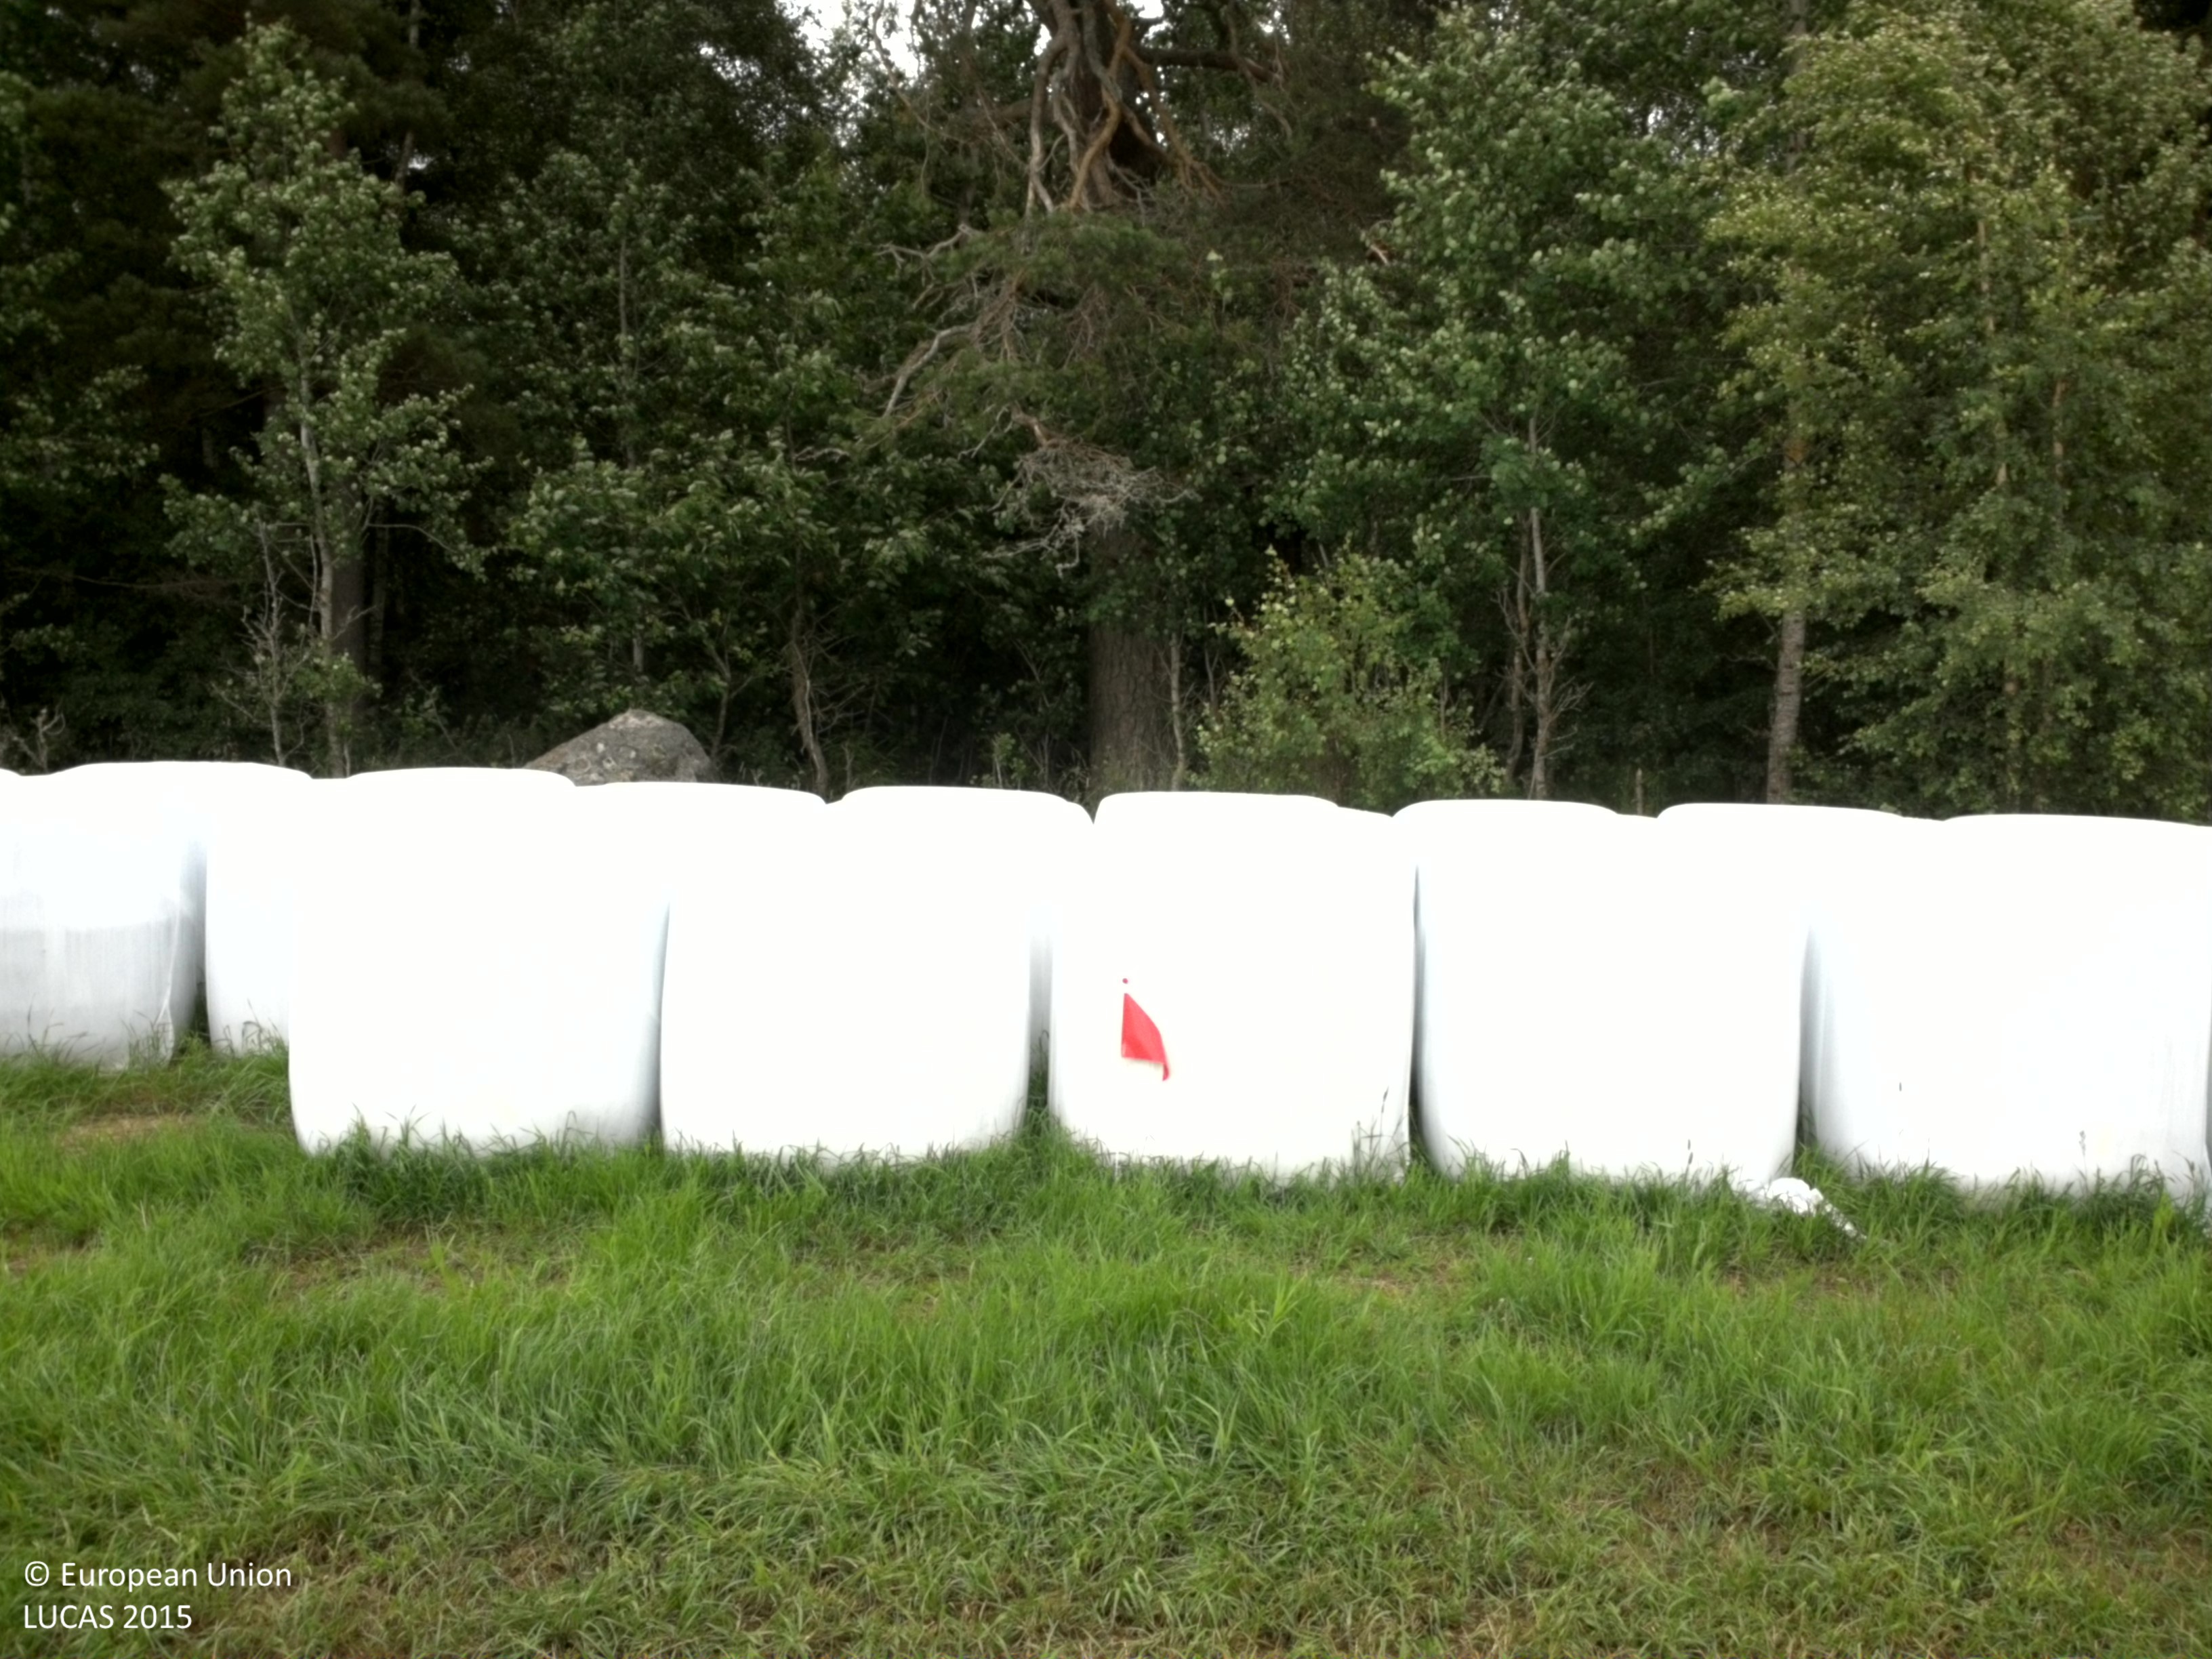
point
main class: Cropland
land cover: Temporary grasslands
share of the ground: > 75 %
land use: Agriculture (excluding fallow land and kitchen gardens)
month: July
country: SE
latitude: 58.1614
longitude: 13.9543
